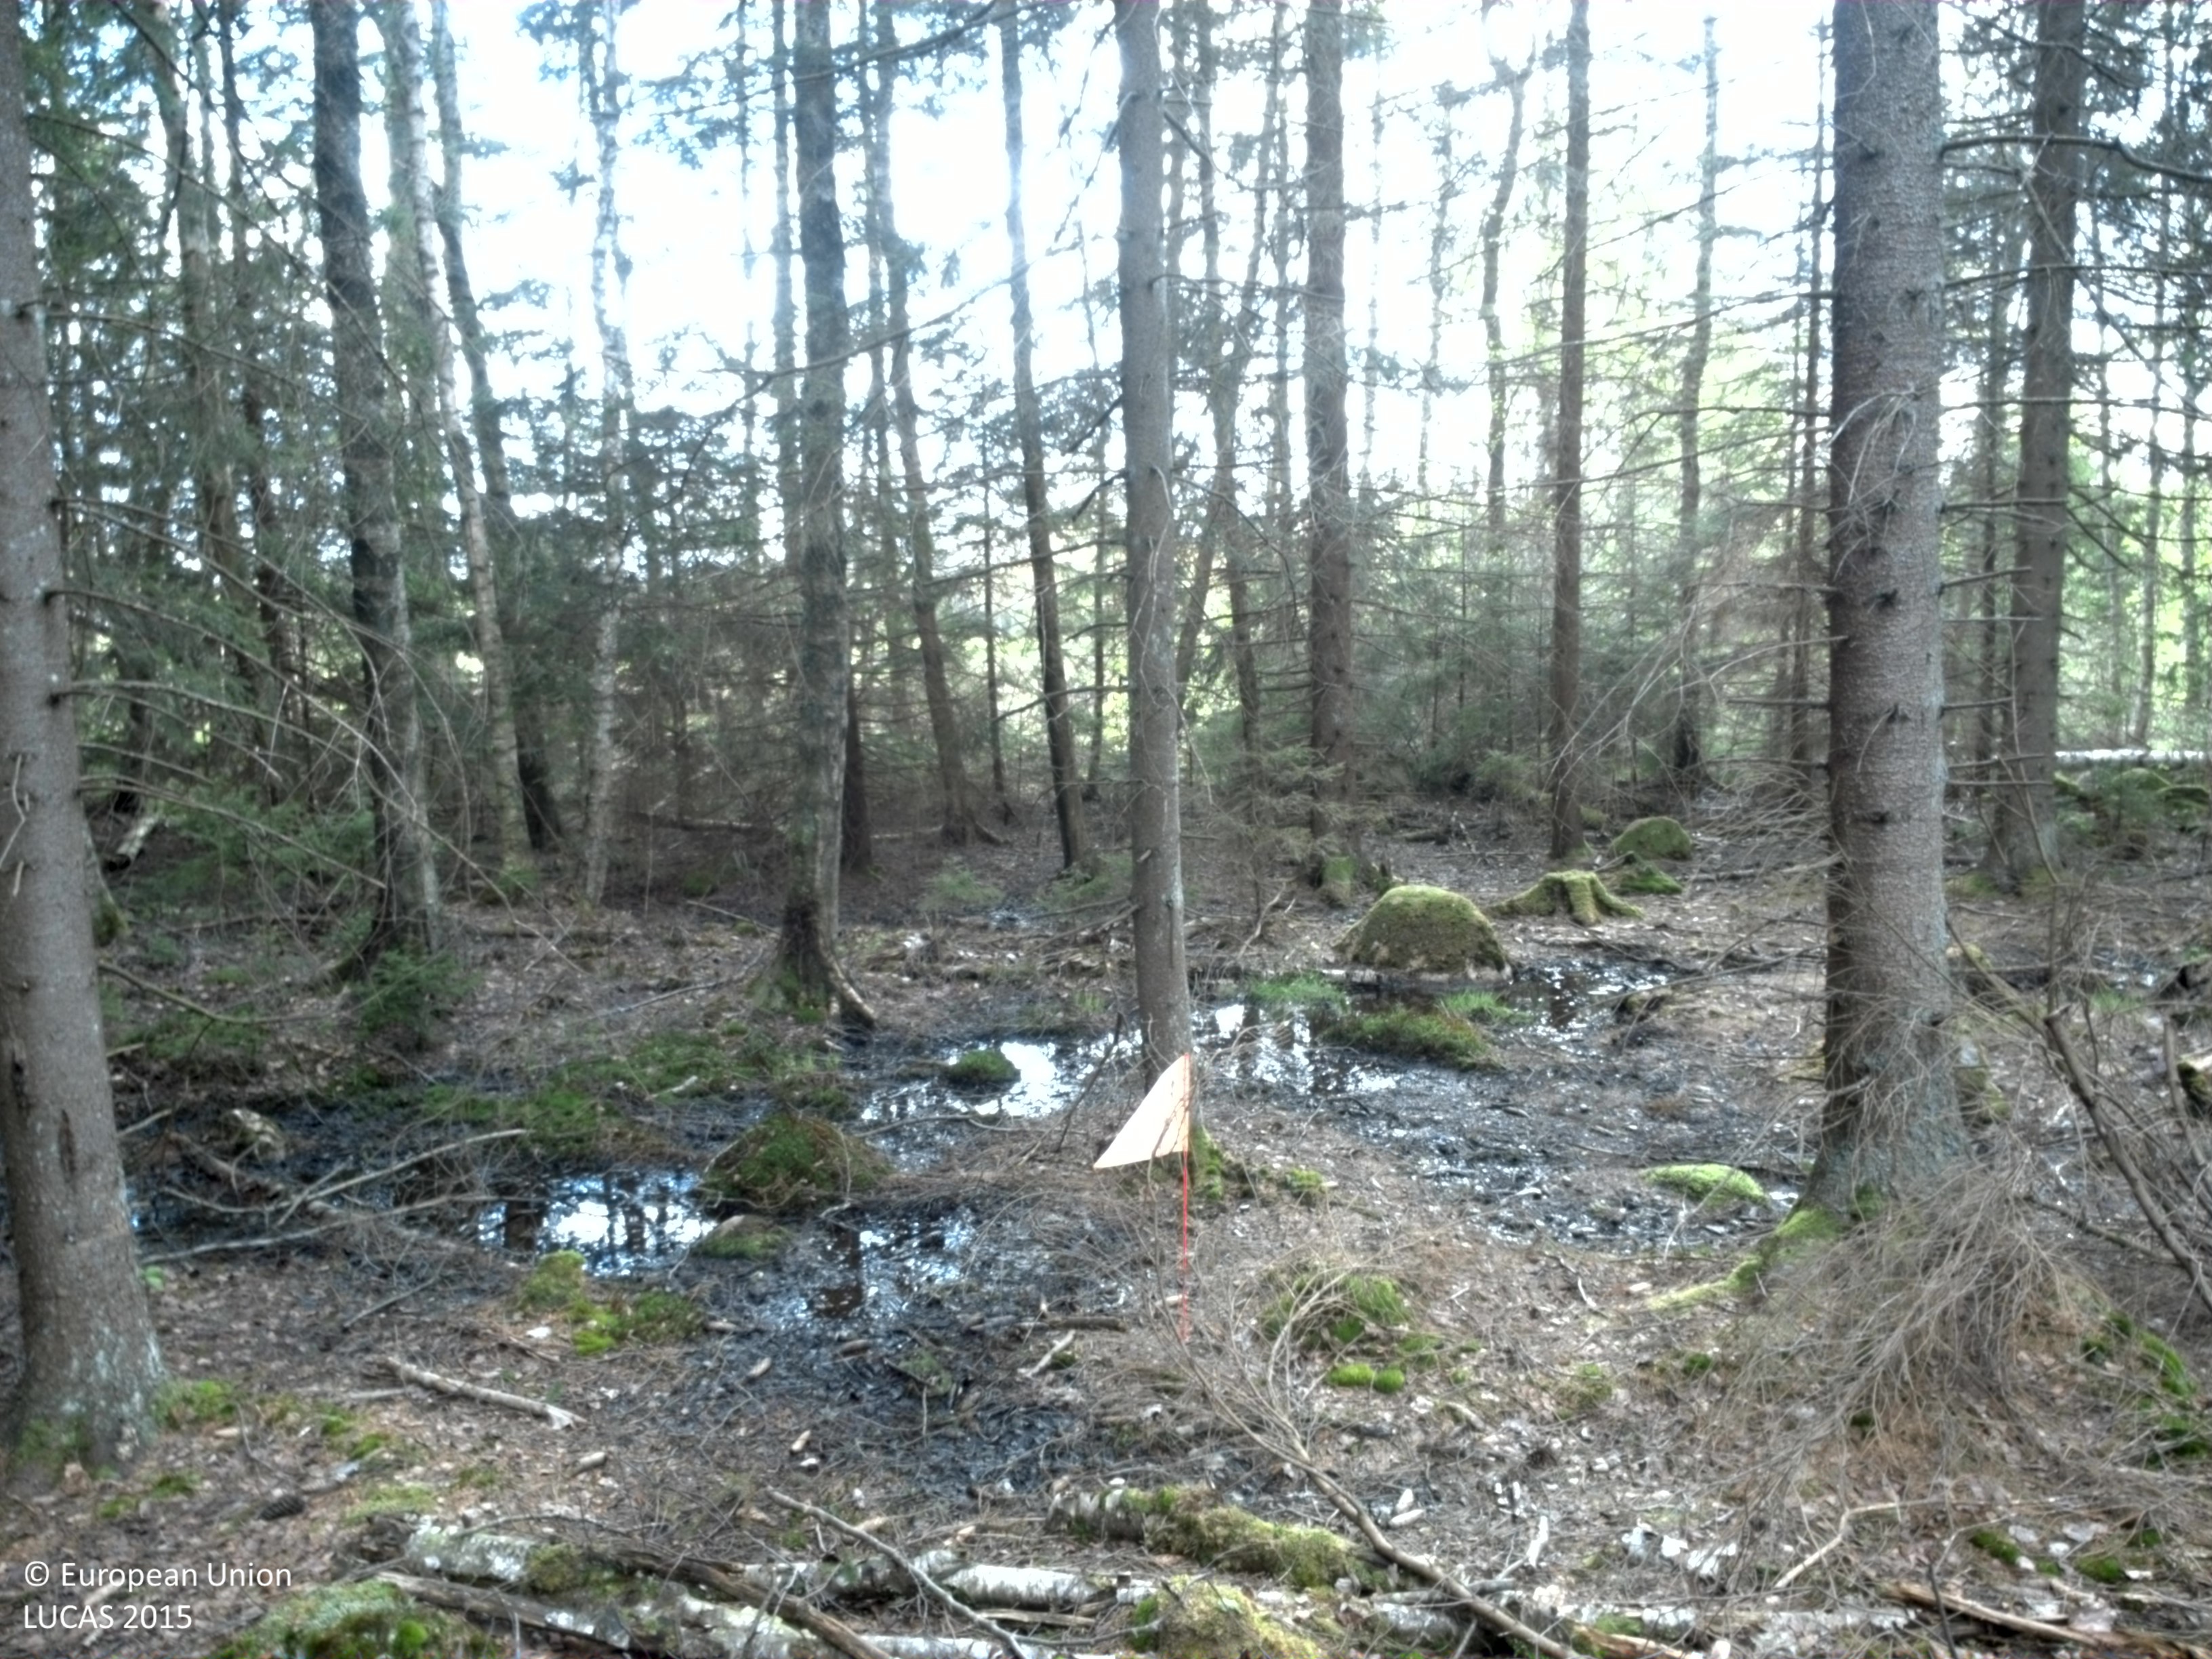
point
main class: Woodland
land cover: Spruce dominated coniferous woodland
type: boreal forest
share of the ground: > 75 %
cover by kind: coniferous forest trees 60 %, broadleaved forest trees 20 %, lichens and mosses 20 %
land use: Forestry
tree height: > 5 m
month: May
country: SE
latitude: 56.6464
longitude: 14.5799
